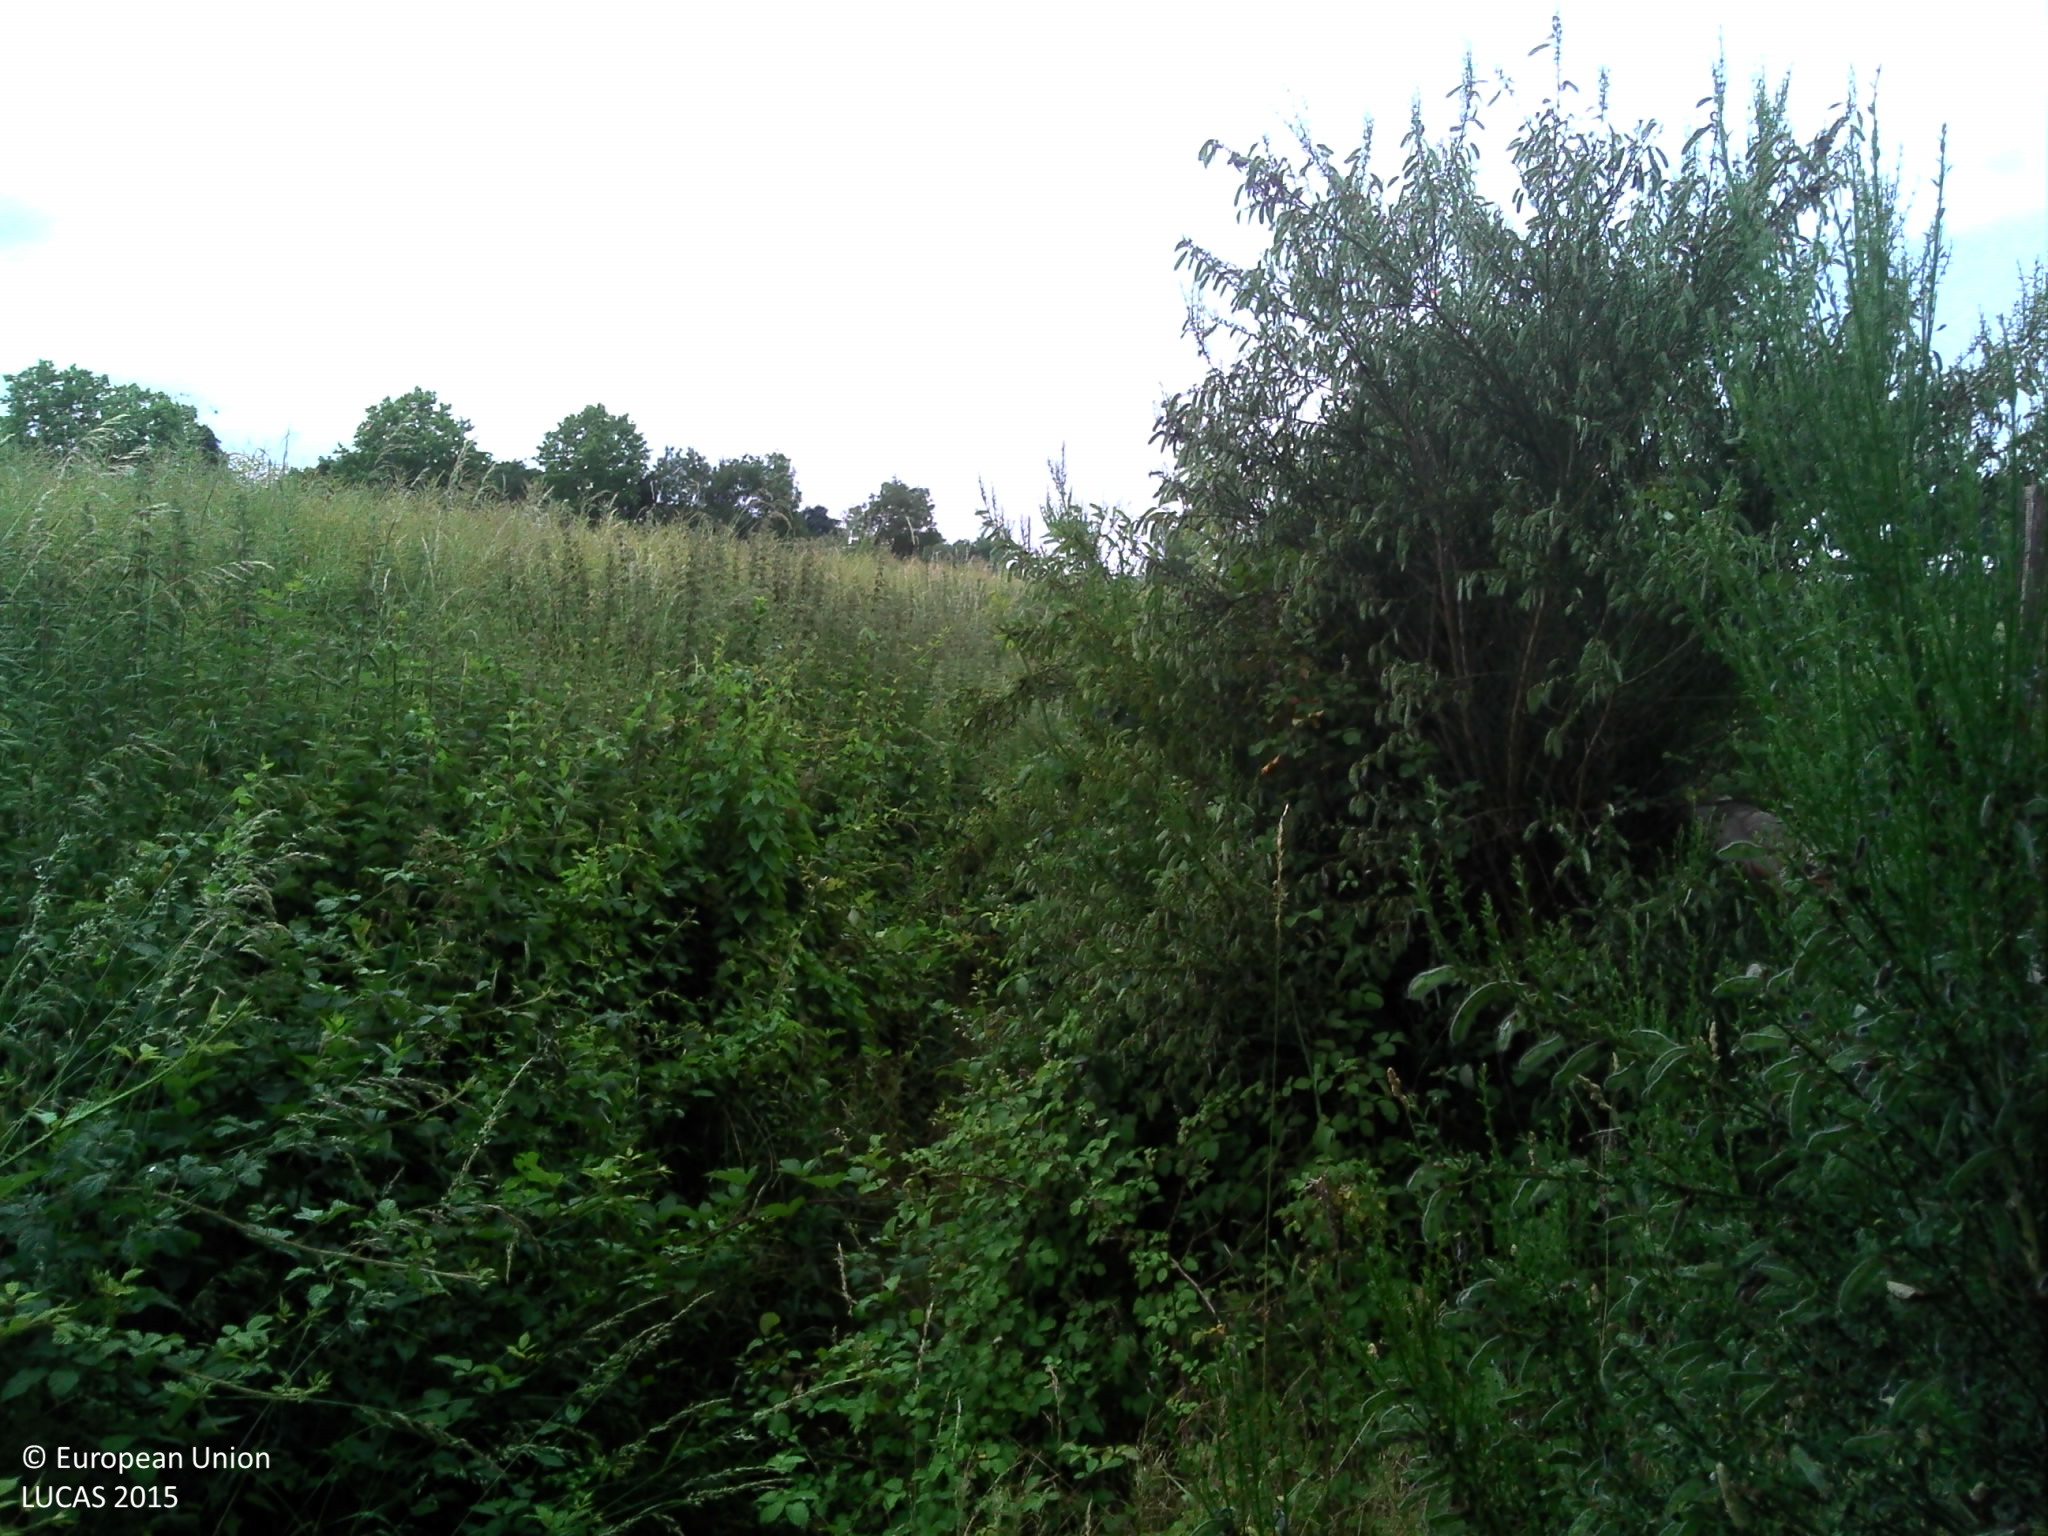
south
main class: Cropland
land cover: Rape and turnip rape
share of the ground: > 75 %
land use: Agriculture (excluding fallow land and kitchen gardens)
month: June
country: FR
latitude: 46.1221
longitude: 4.9170
